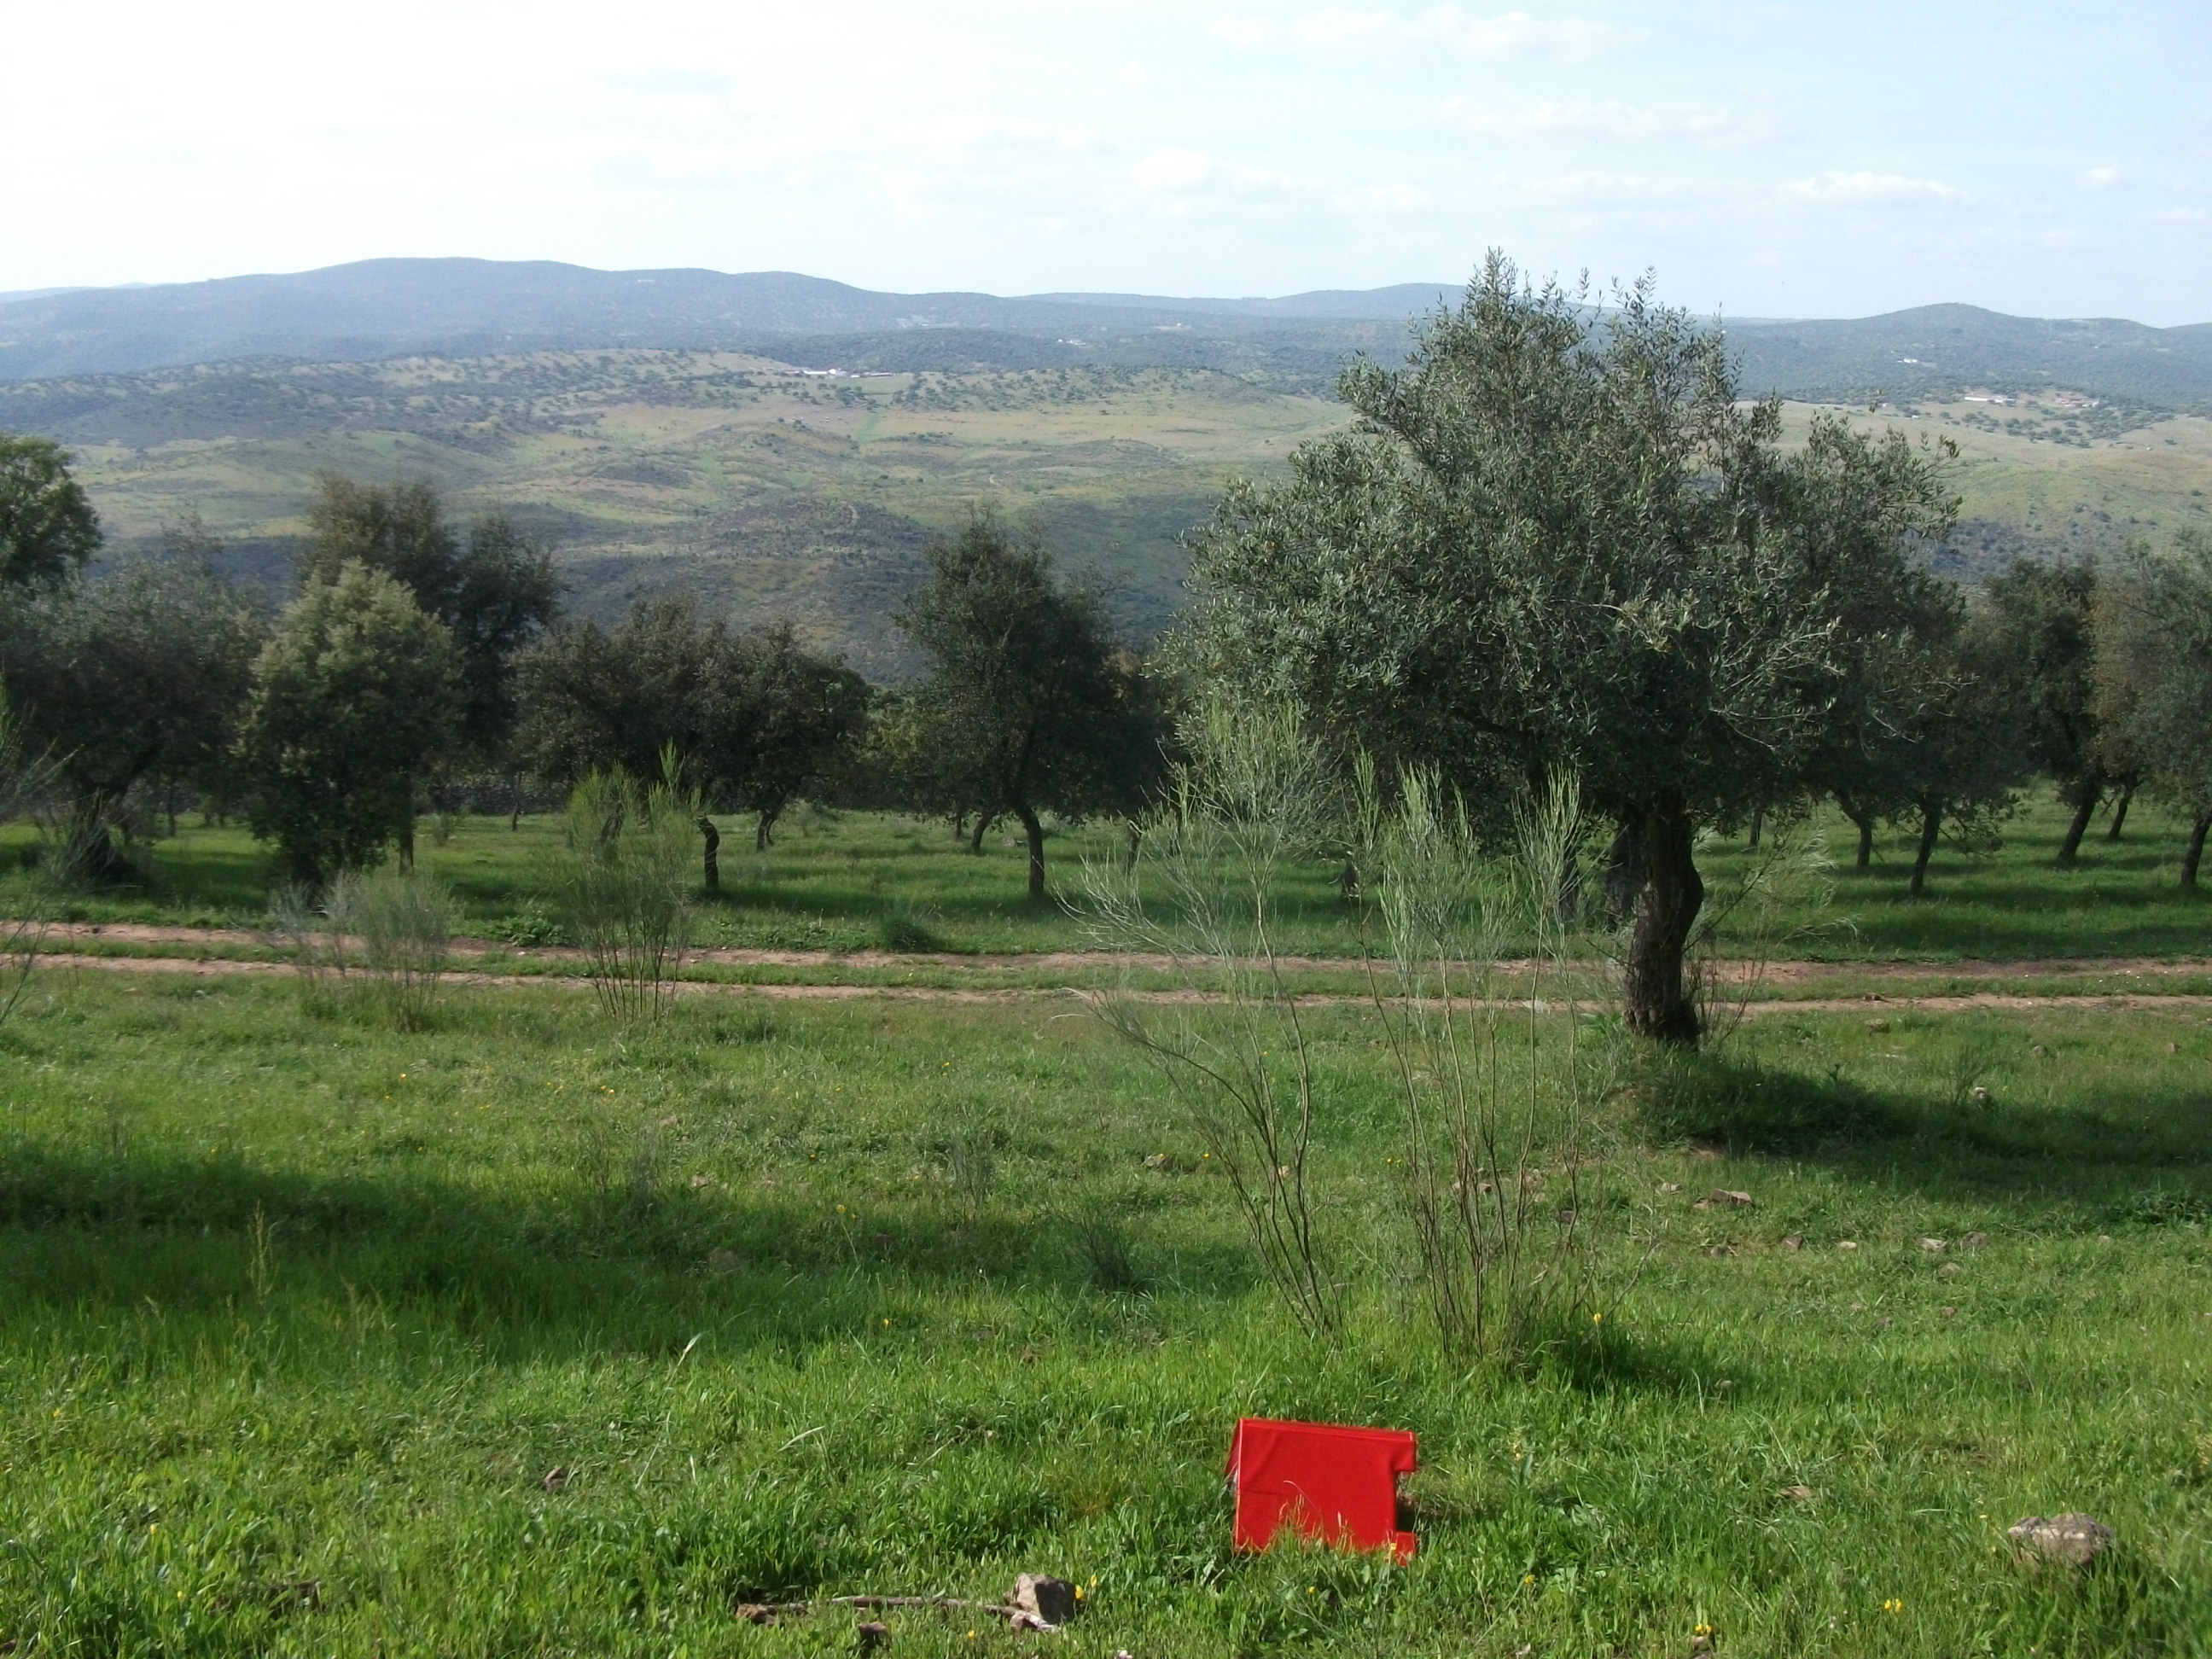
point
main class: Woodland
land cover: Broadleaved woodland
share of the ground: 50 - 75 %
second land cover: Olive groves
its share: 10 - 25 %
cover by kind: broadleaved forest trees 70 %, herbaceous plants 10 %
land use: Forestry
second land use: Agriculture (excluding fallow land and kitchen gardens)
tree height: < 5 m
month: April
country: ES
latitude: 38.0817
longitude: -6.7293
